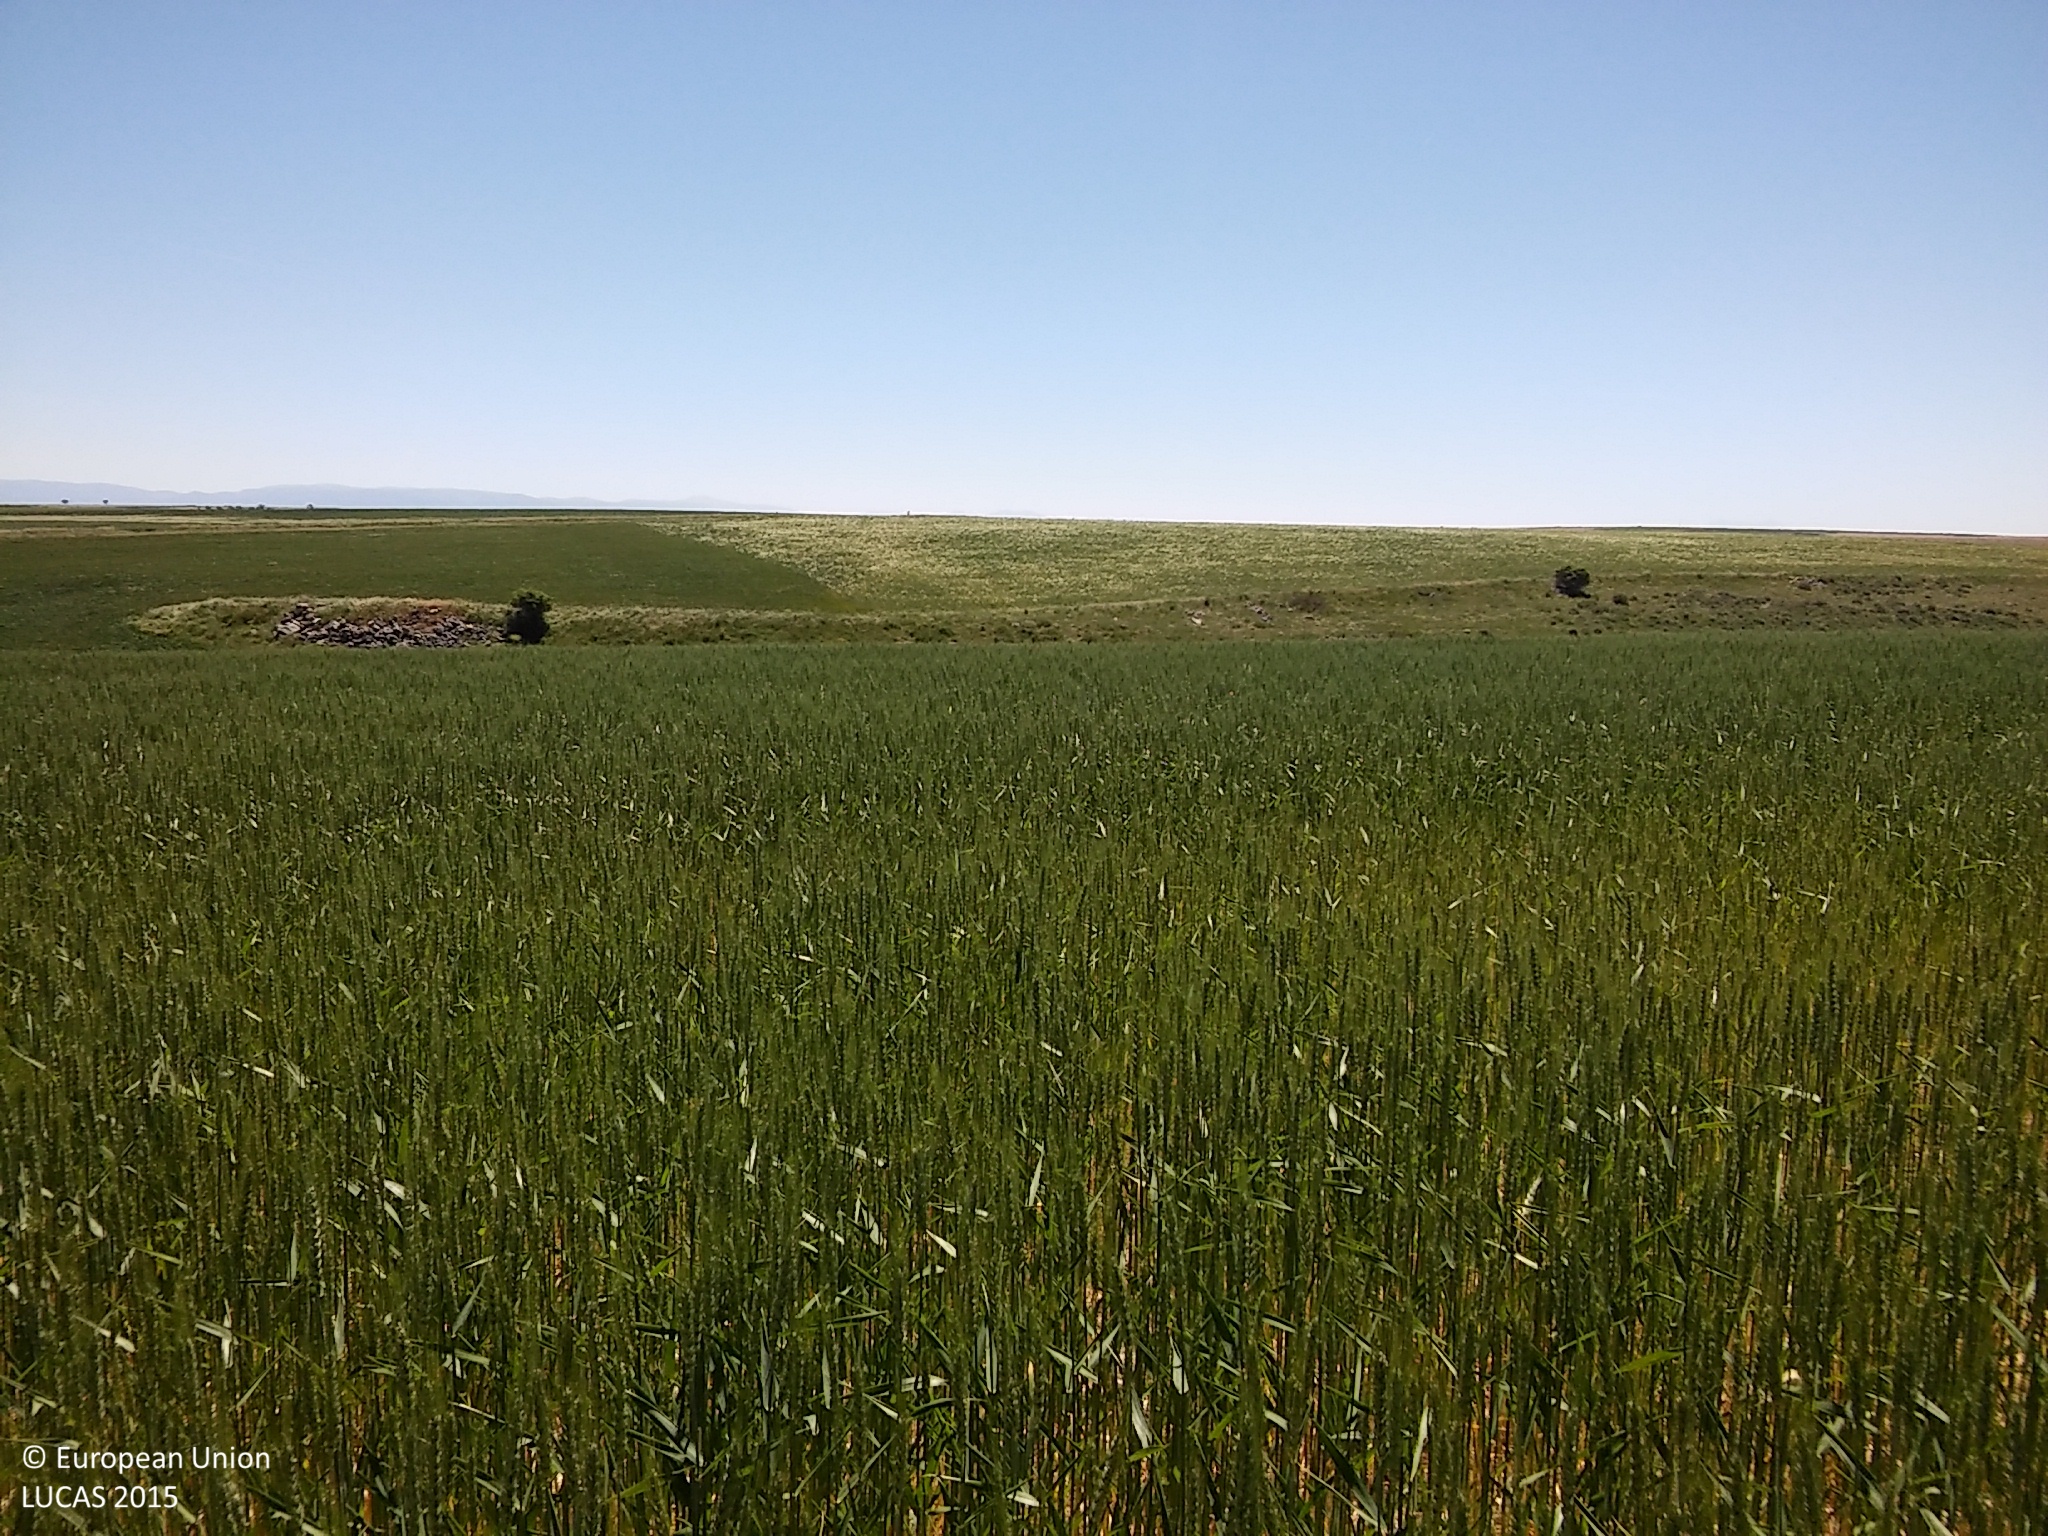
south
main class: Cropland
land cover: Common wheat
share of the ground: > 75 %
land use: Agriculture (excluding fallow land and kitchen gardens)
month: May
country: ES
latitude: 41.4708
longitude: -4.0292
